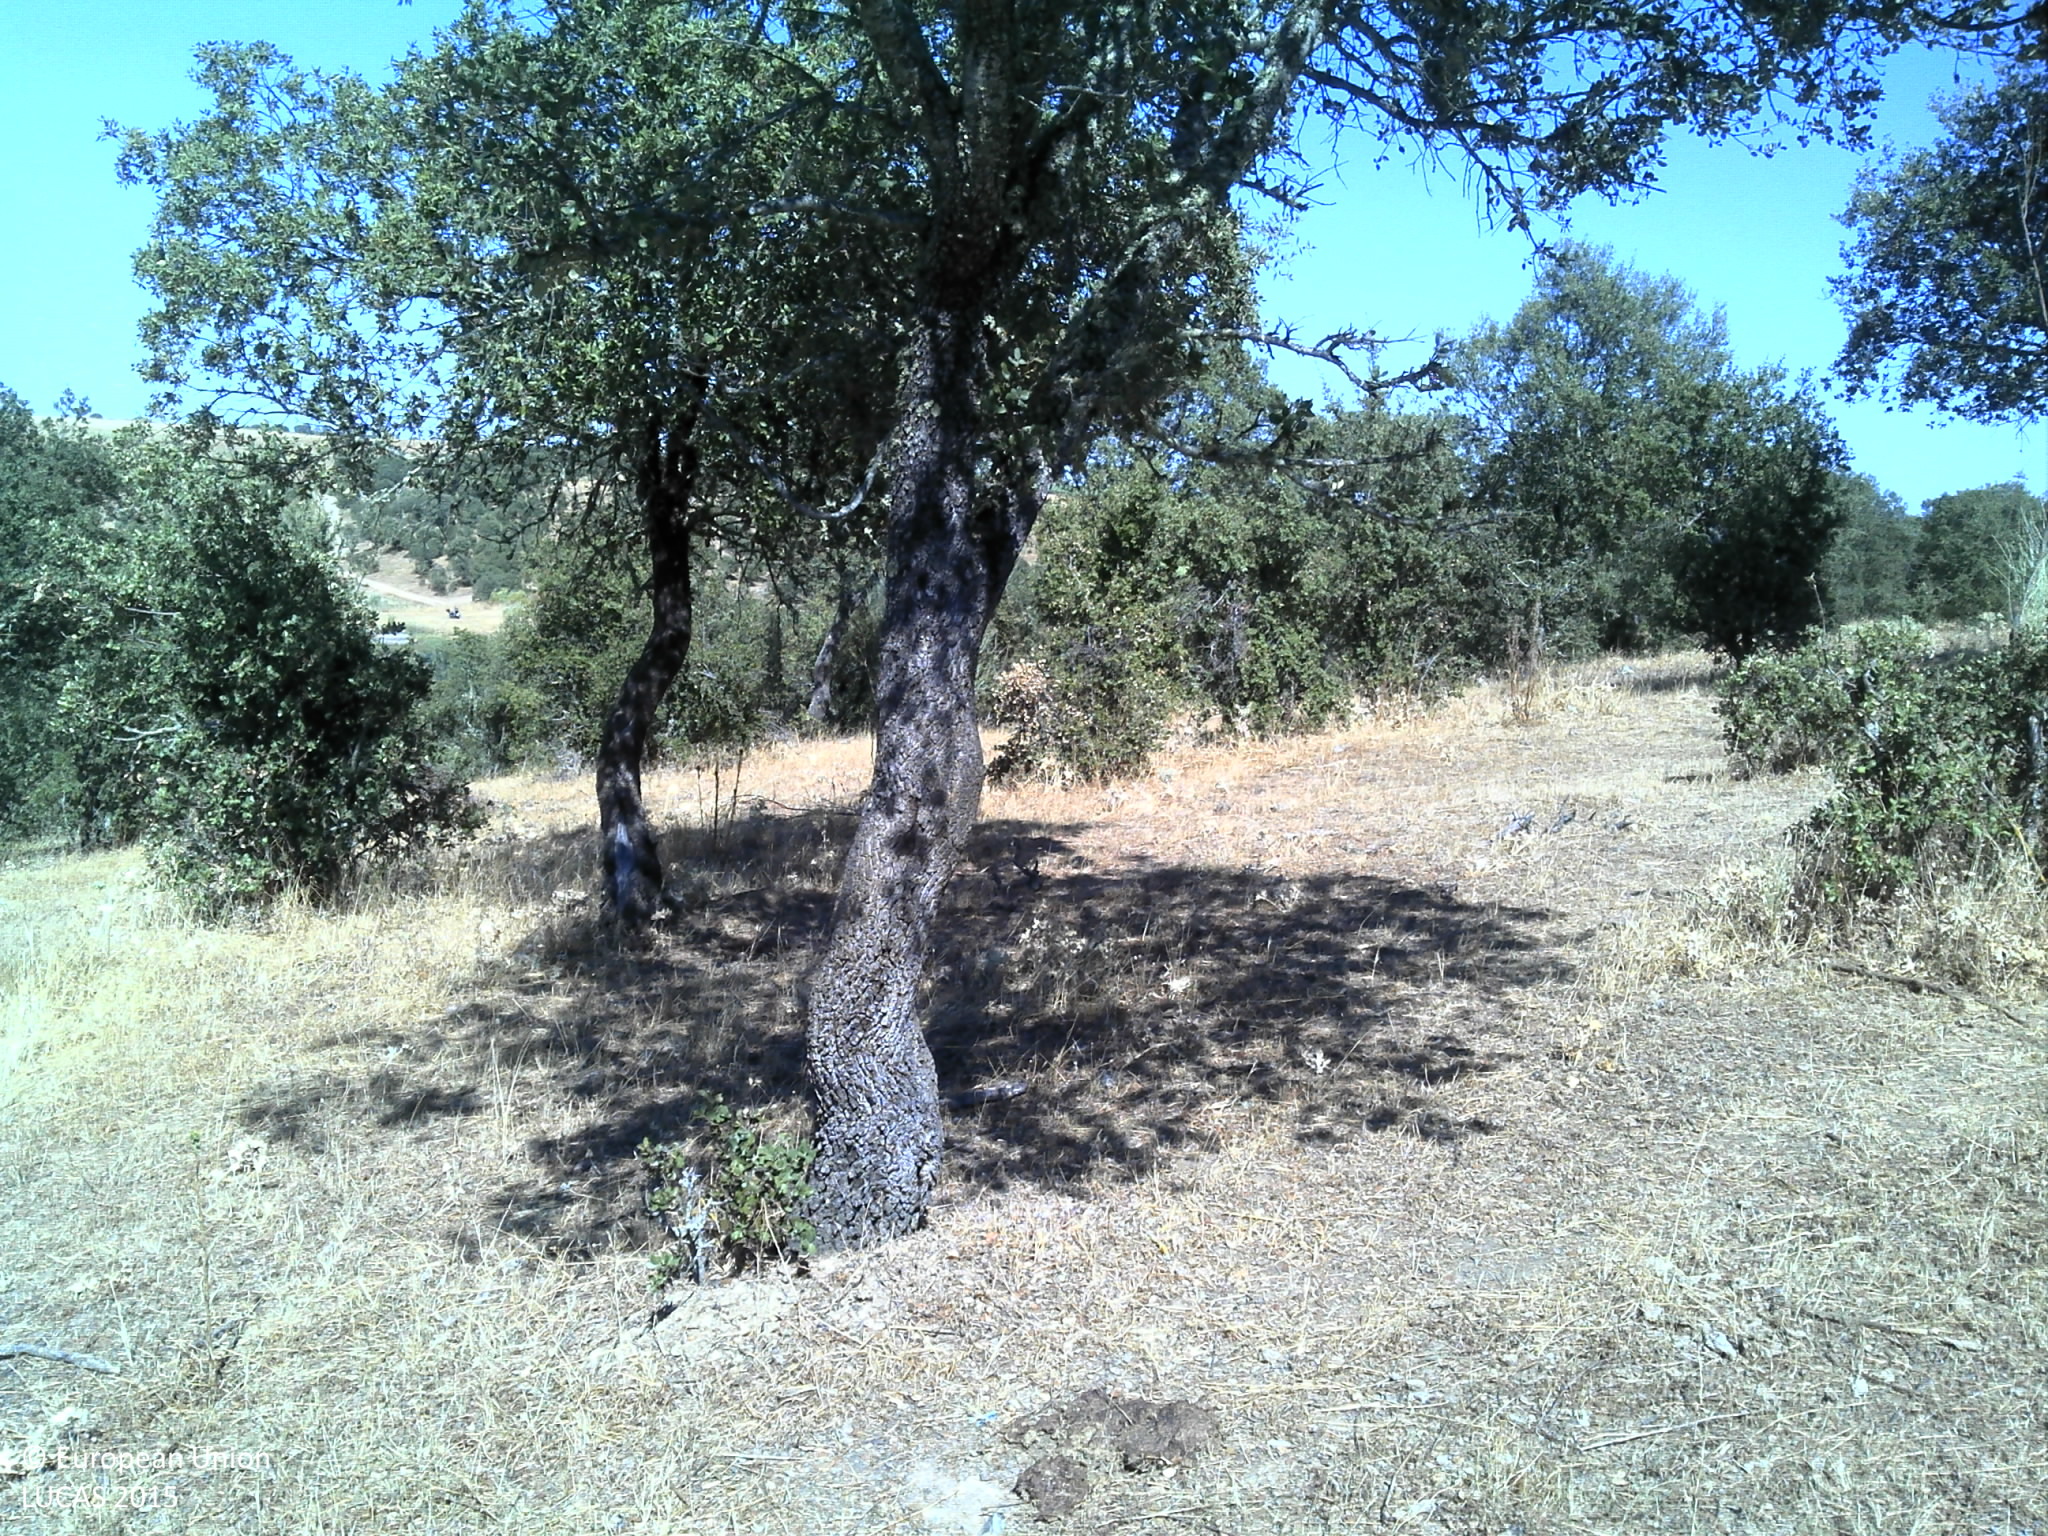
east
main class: Woodland
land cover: Broadleaved woodland
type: broadleaved evergreen forest
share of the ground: 25 - 50 %
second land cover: Grassland without tree/shrub cover
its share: 25 - 50 %
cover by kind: unconsolidated bare surface 40 %, broadleaved forest trees 35 %, herbaceous plants 25 %
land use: Forestry
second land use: Agriculture (excluding fallow land and kitchen gardens)
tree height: > 5 m
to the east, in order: Broadleaved woodland; Grassland without tree/shrub cover; Fences; Spontaneously vegetated surfaces; Inland fresh water bodies
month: July
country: PT
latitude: 38.1494
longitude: -7.3756
